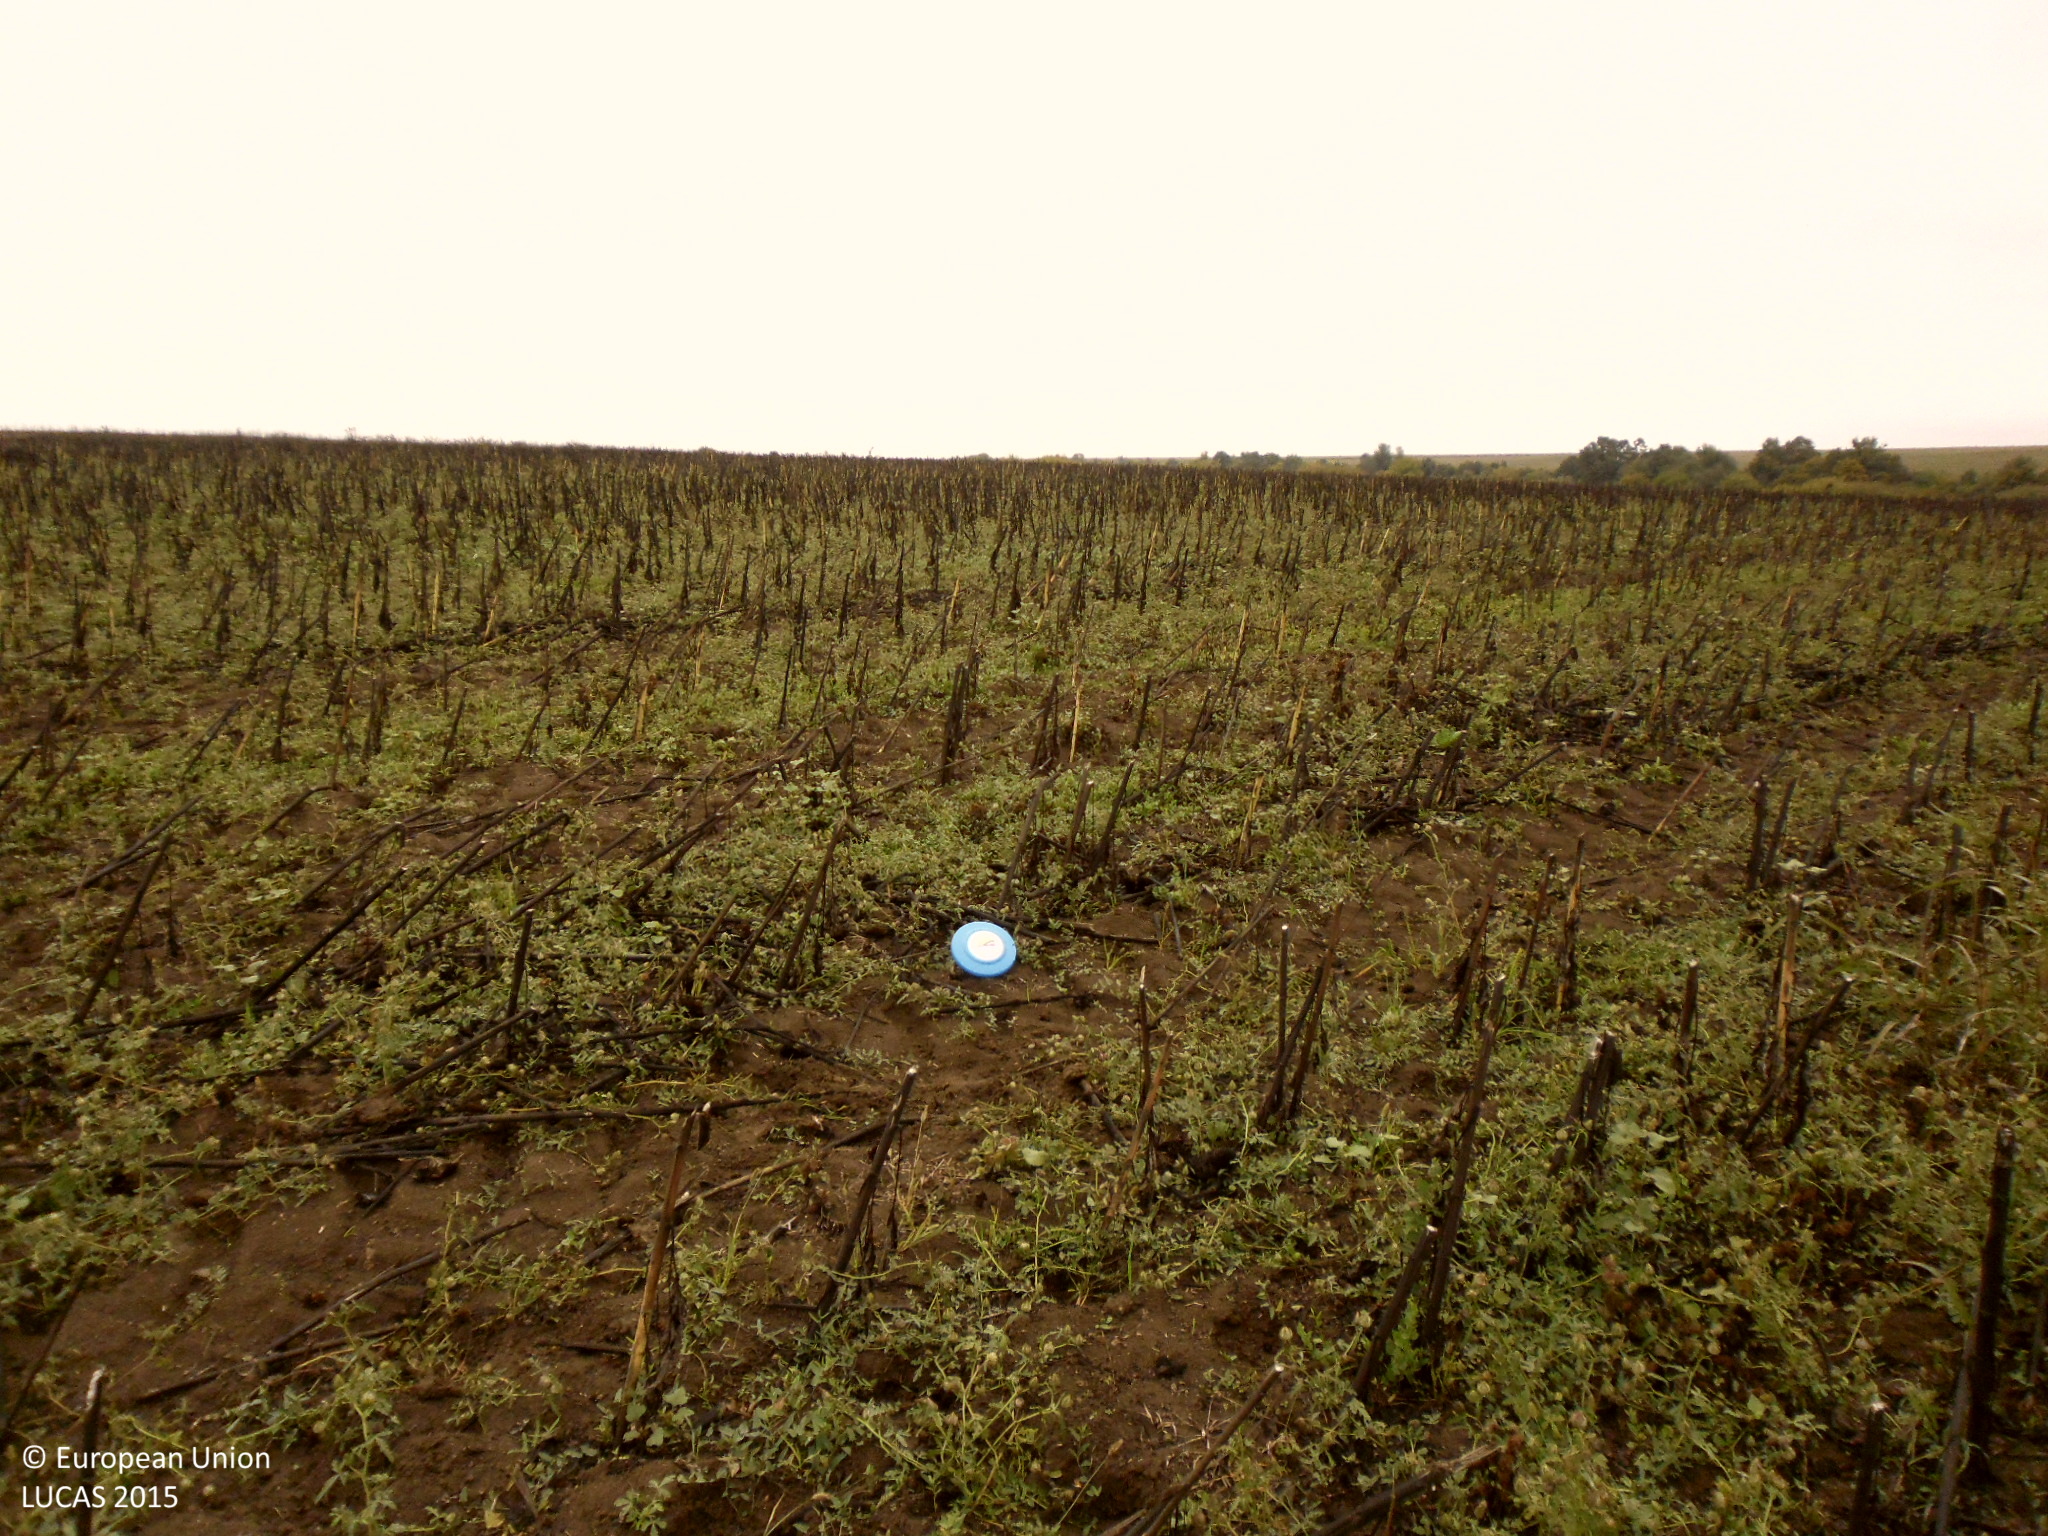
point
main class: Cropland
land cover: Sunflower
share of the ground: 10 - 25 %
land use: Agriculture (excluding fallow land and kitchen gardens)
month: October
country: BG
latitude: 43.6788
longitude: 22.8249
